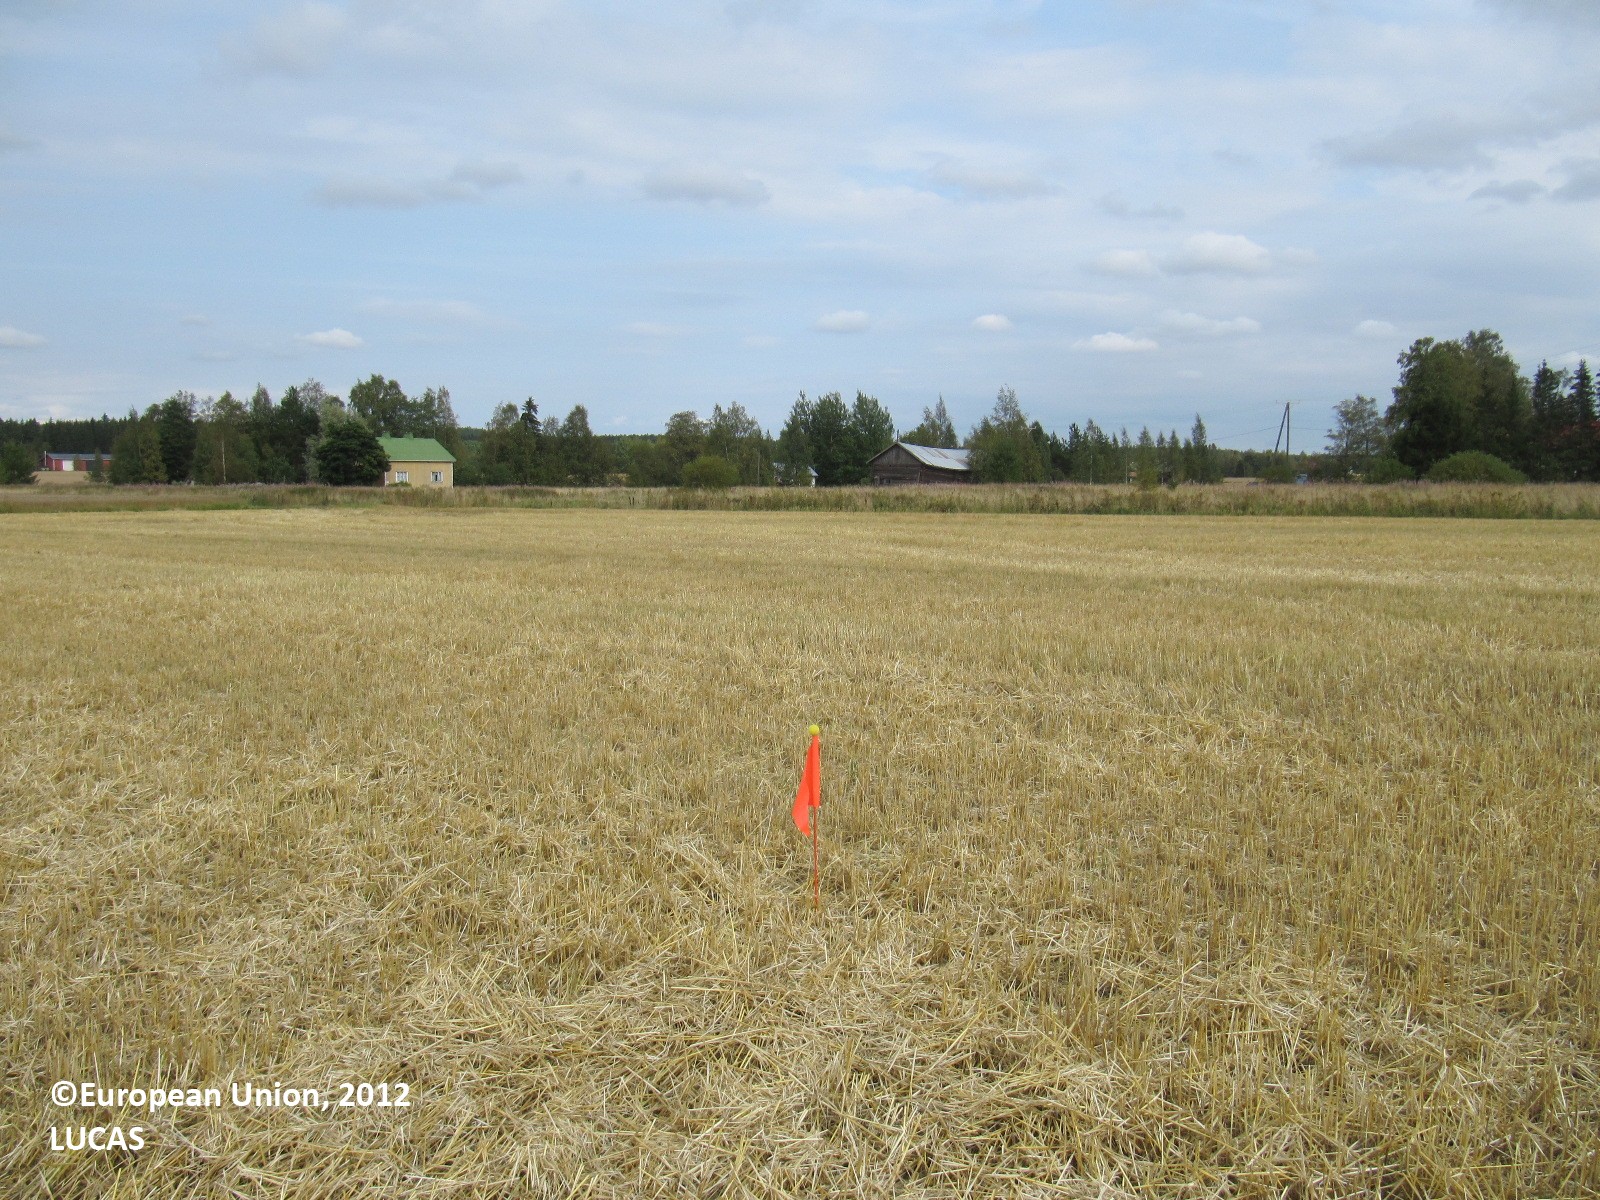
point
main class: Cropland
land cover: Barley
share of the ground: > 75 %
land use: Agriculture (excluding fallow land and kitchen gardens)
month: August
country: FI
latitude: 61.1389
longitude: 22.9054
